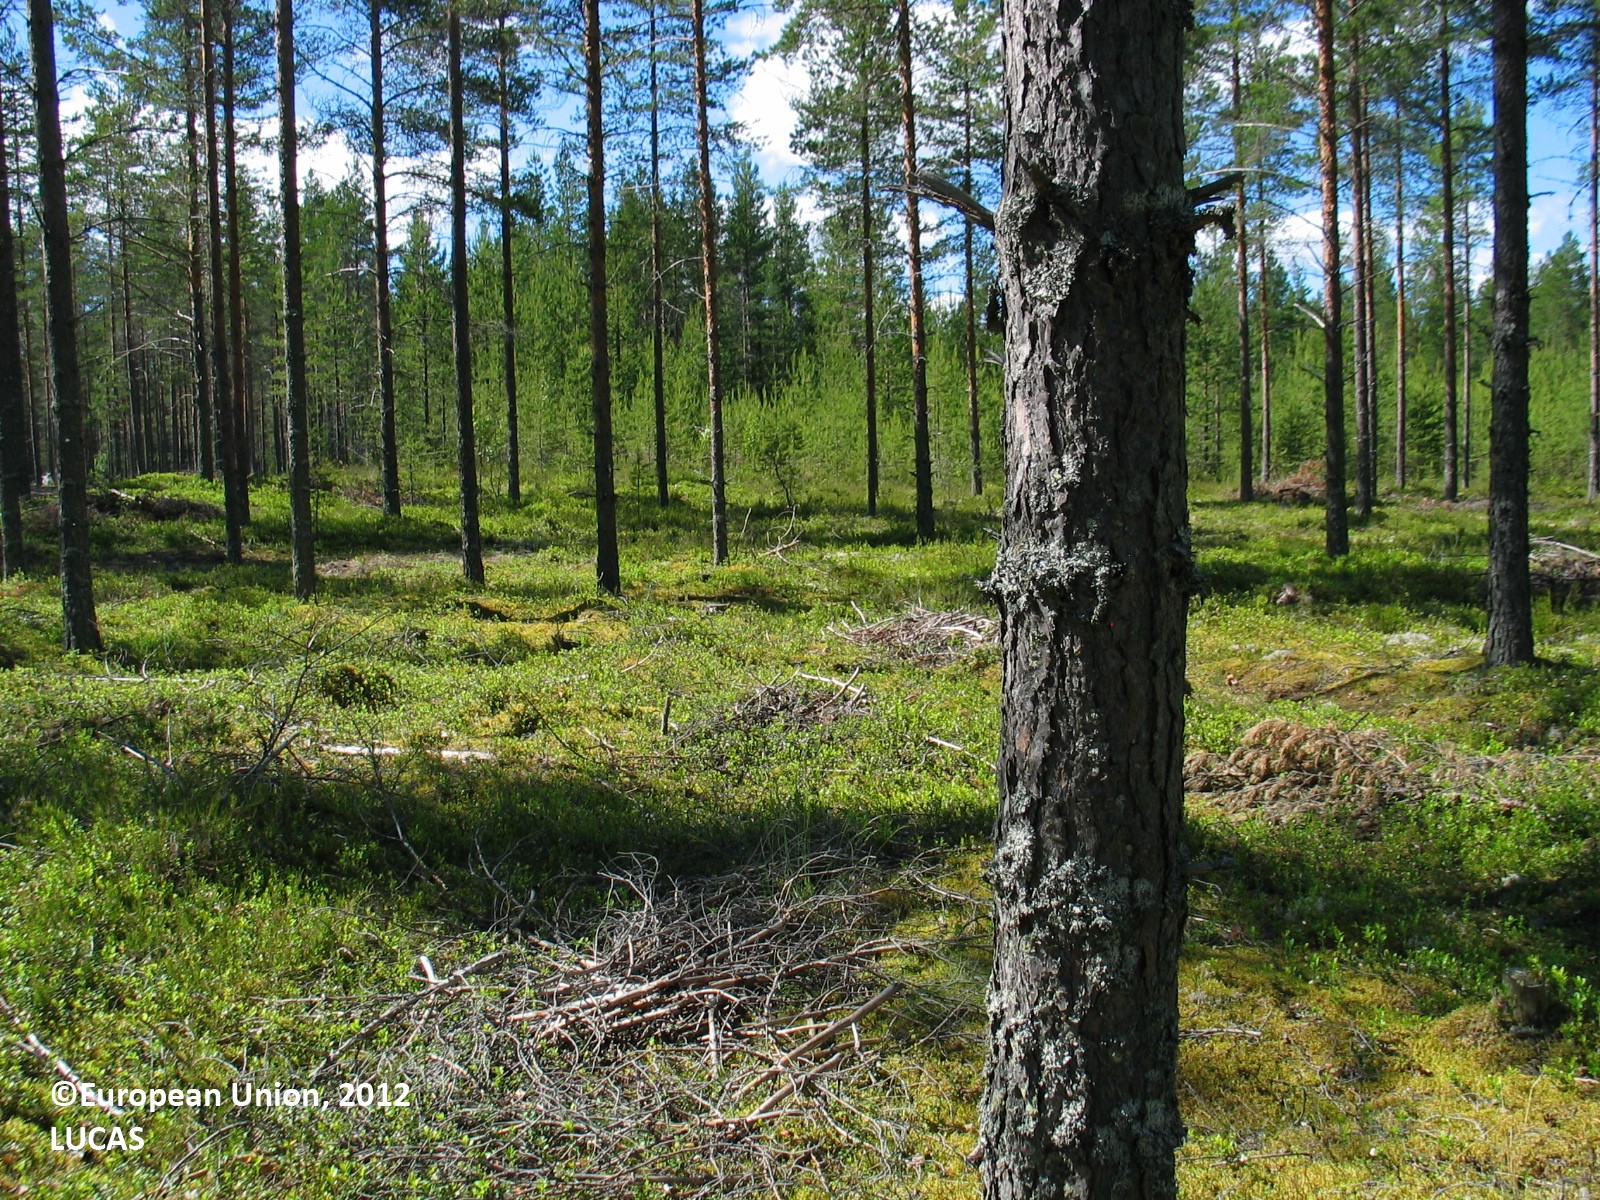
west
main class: Woodland
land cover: Pine dominated coniferous woodland
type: boreal forest
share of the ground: 25 - 50 %
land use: Forestry
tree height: > 5 m
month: July
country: FI
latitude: 64.7299
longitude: 26.5089
